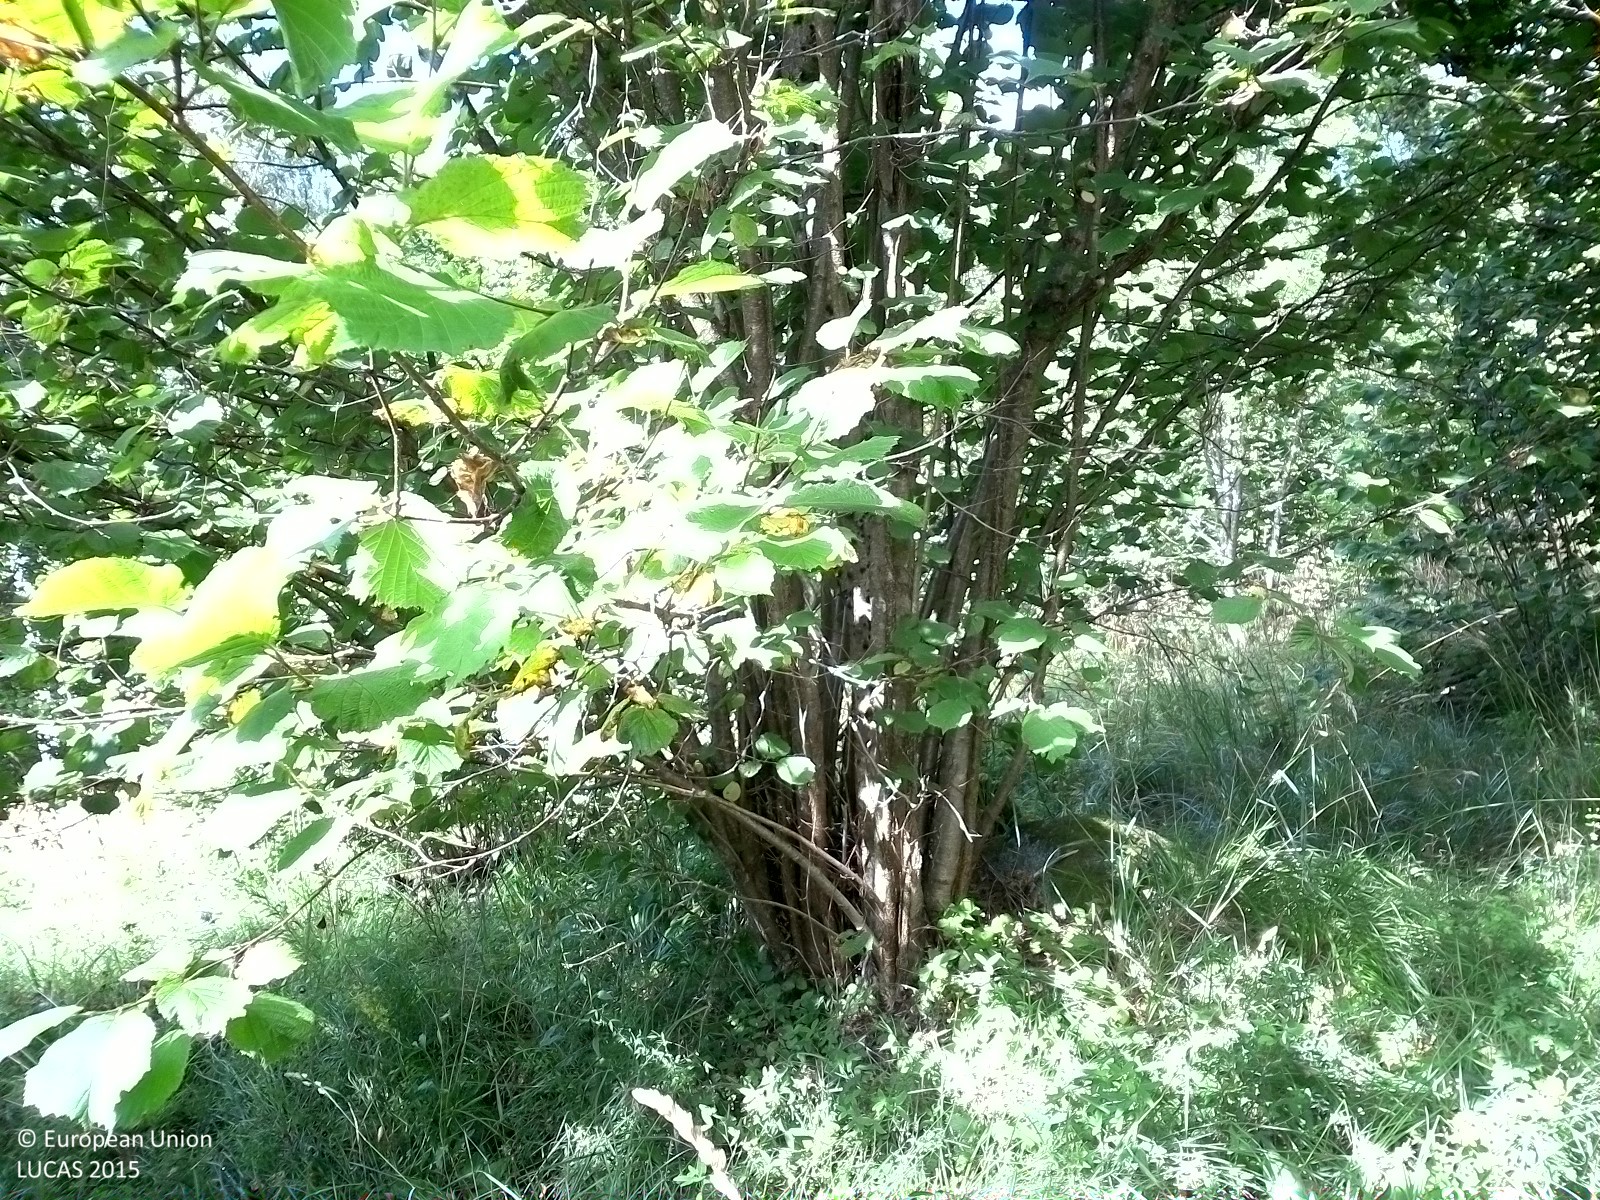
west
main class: Woodland
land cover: Broadleaved woodland
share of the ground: 25 - 50 %
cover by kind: broadleaved forest trees 45 %, herbaceous plants 40 %, shrubs 15 %
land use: Semi-natural and natural areas not in use
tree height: < 5 m
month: August
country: SE
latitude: 59.1672
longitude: 14.6273
